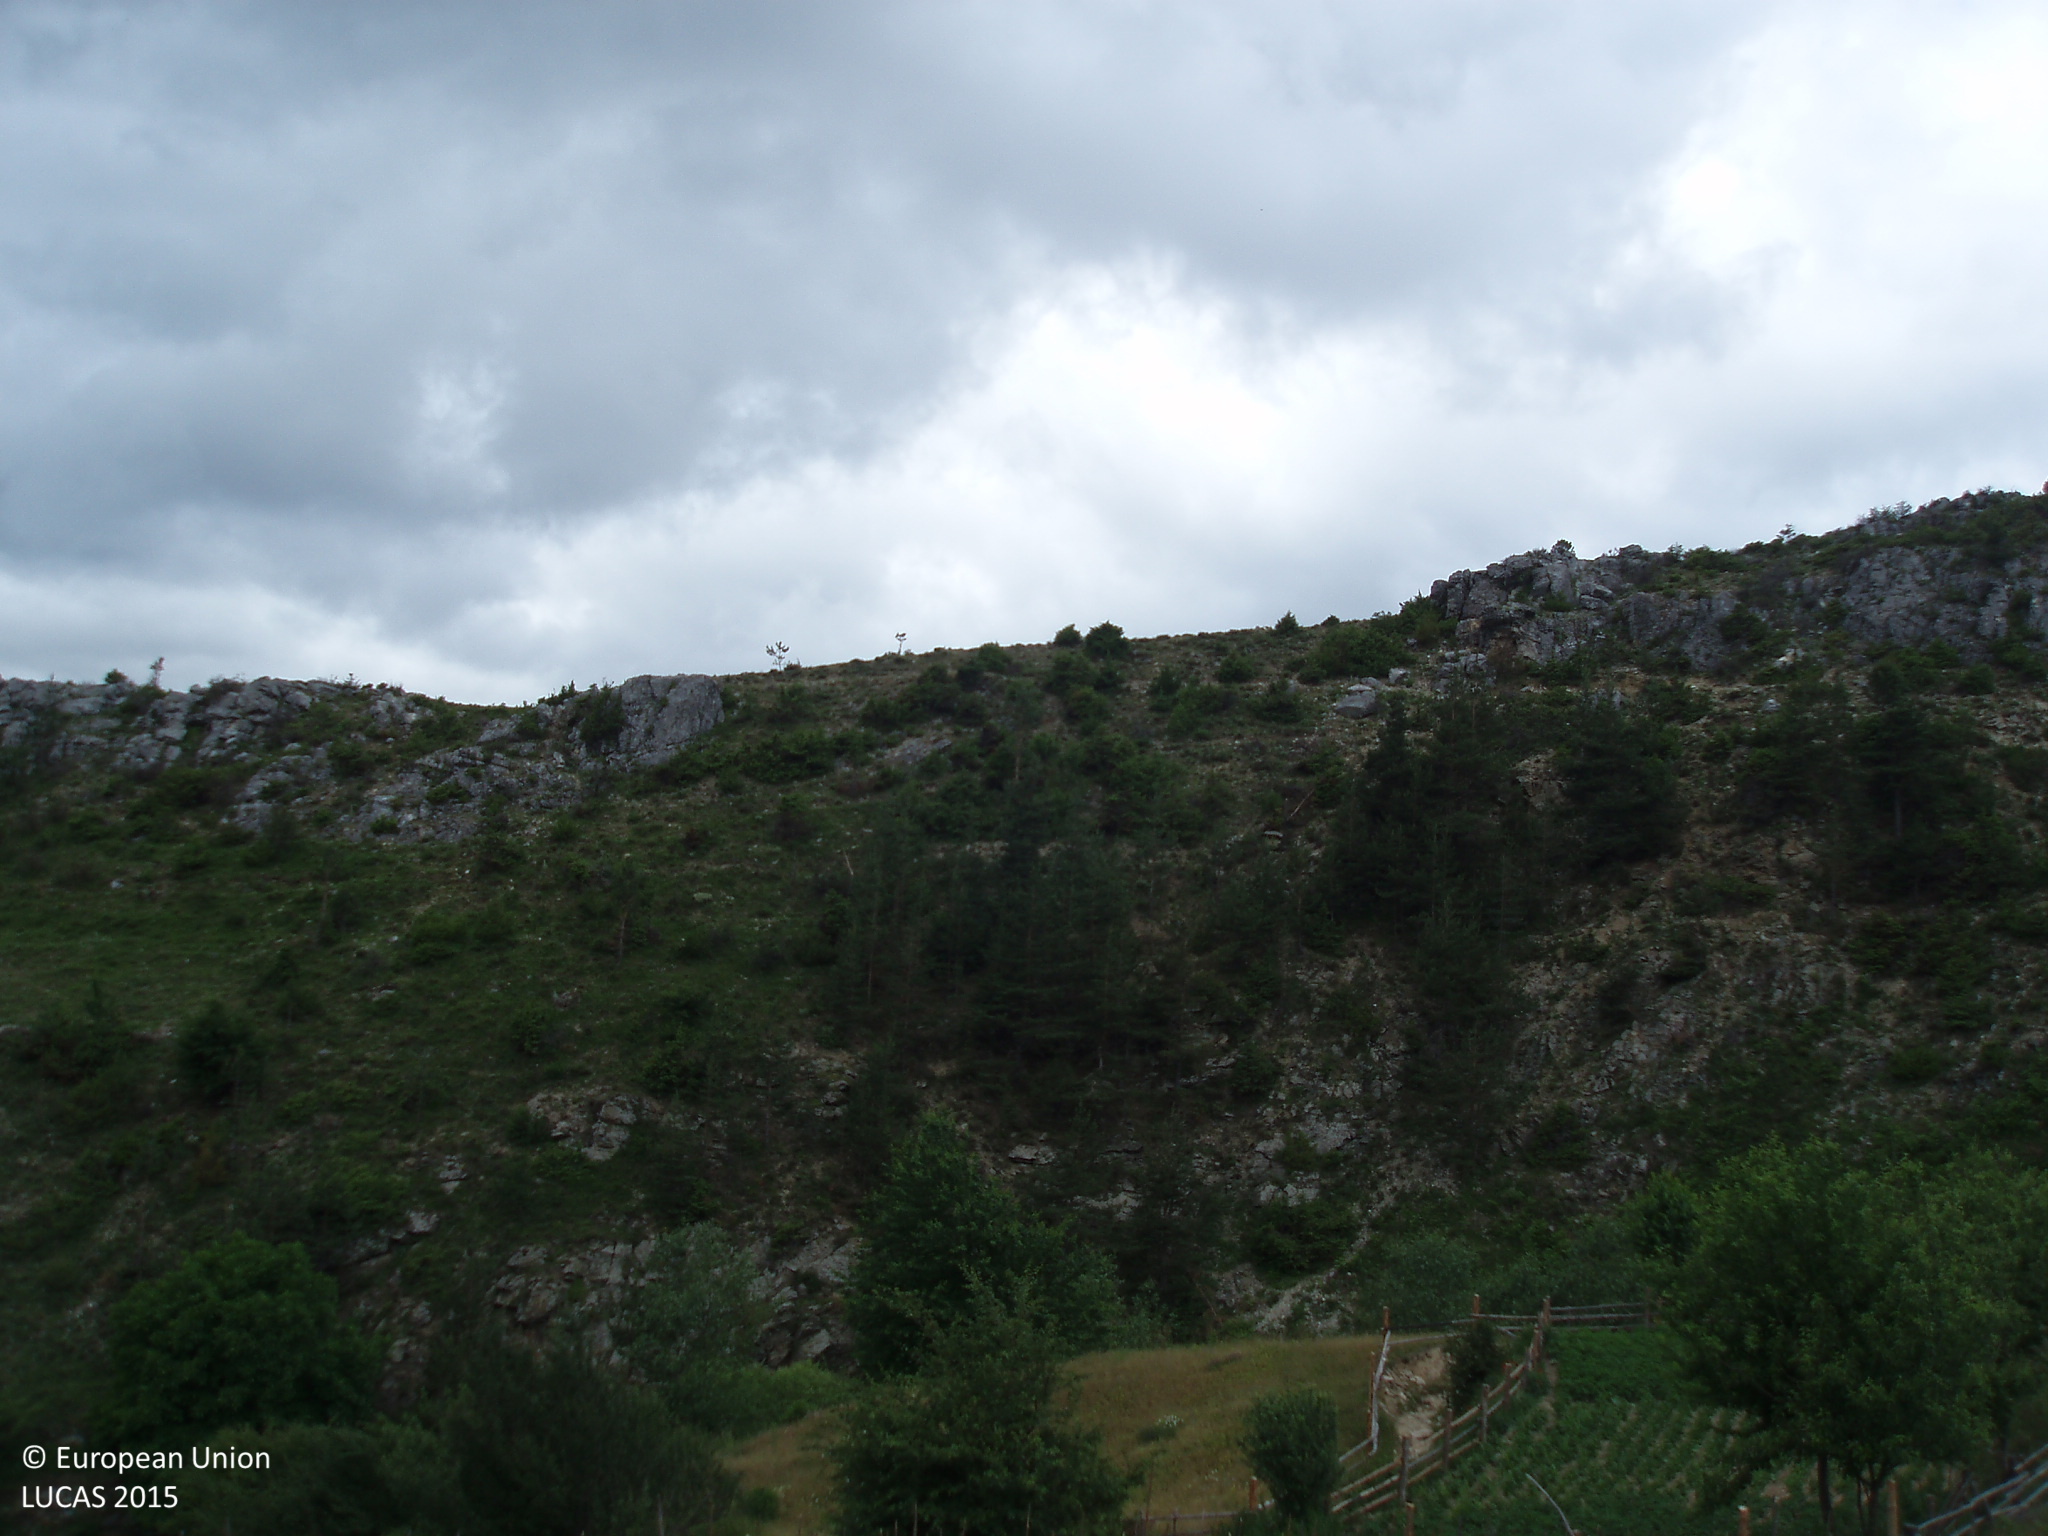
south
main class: Grassland
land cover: Grassland without tree/shrub cover
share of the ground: > 75 %
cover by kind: herbaceous plants 100 %
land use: Agriculture (excluding fallow land and kitchen gardens)
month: June
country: BG
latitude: 41.7266
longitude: 23.7711
